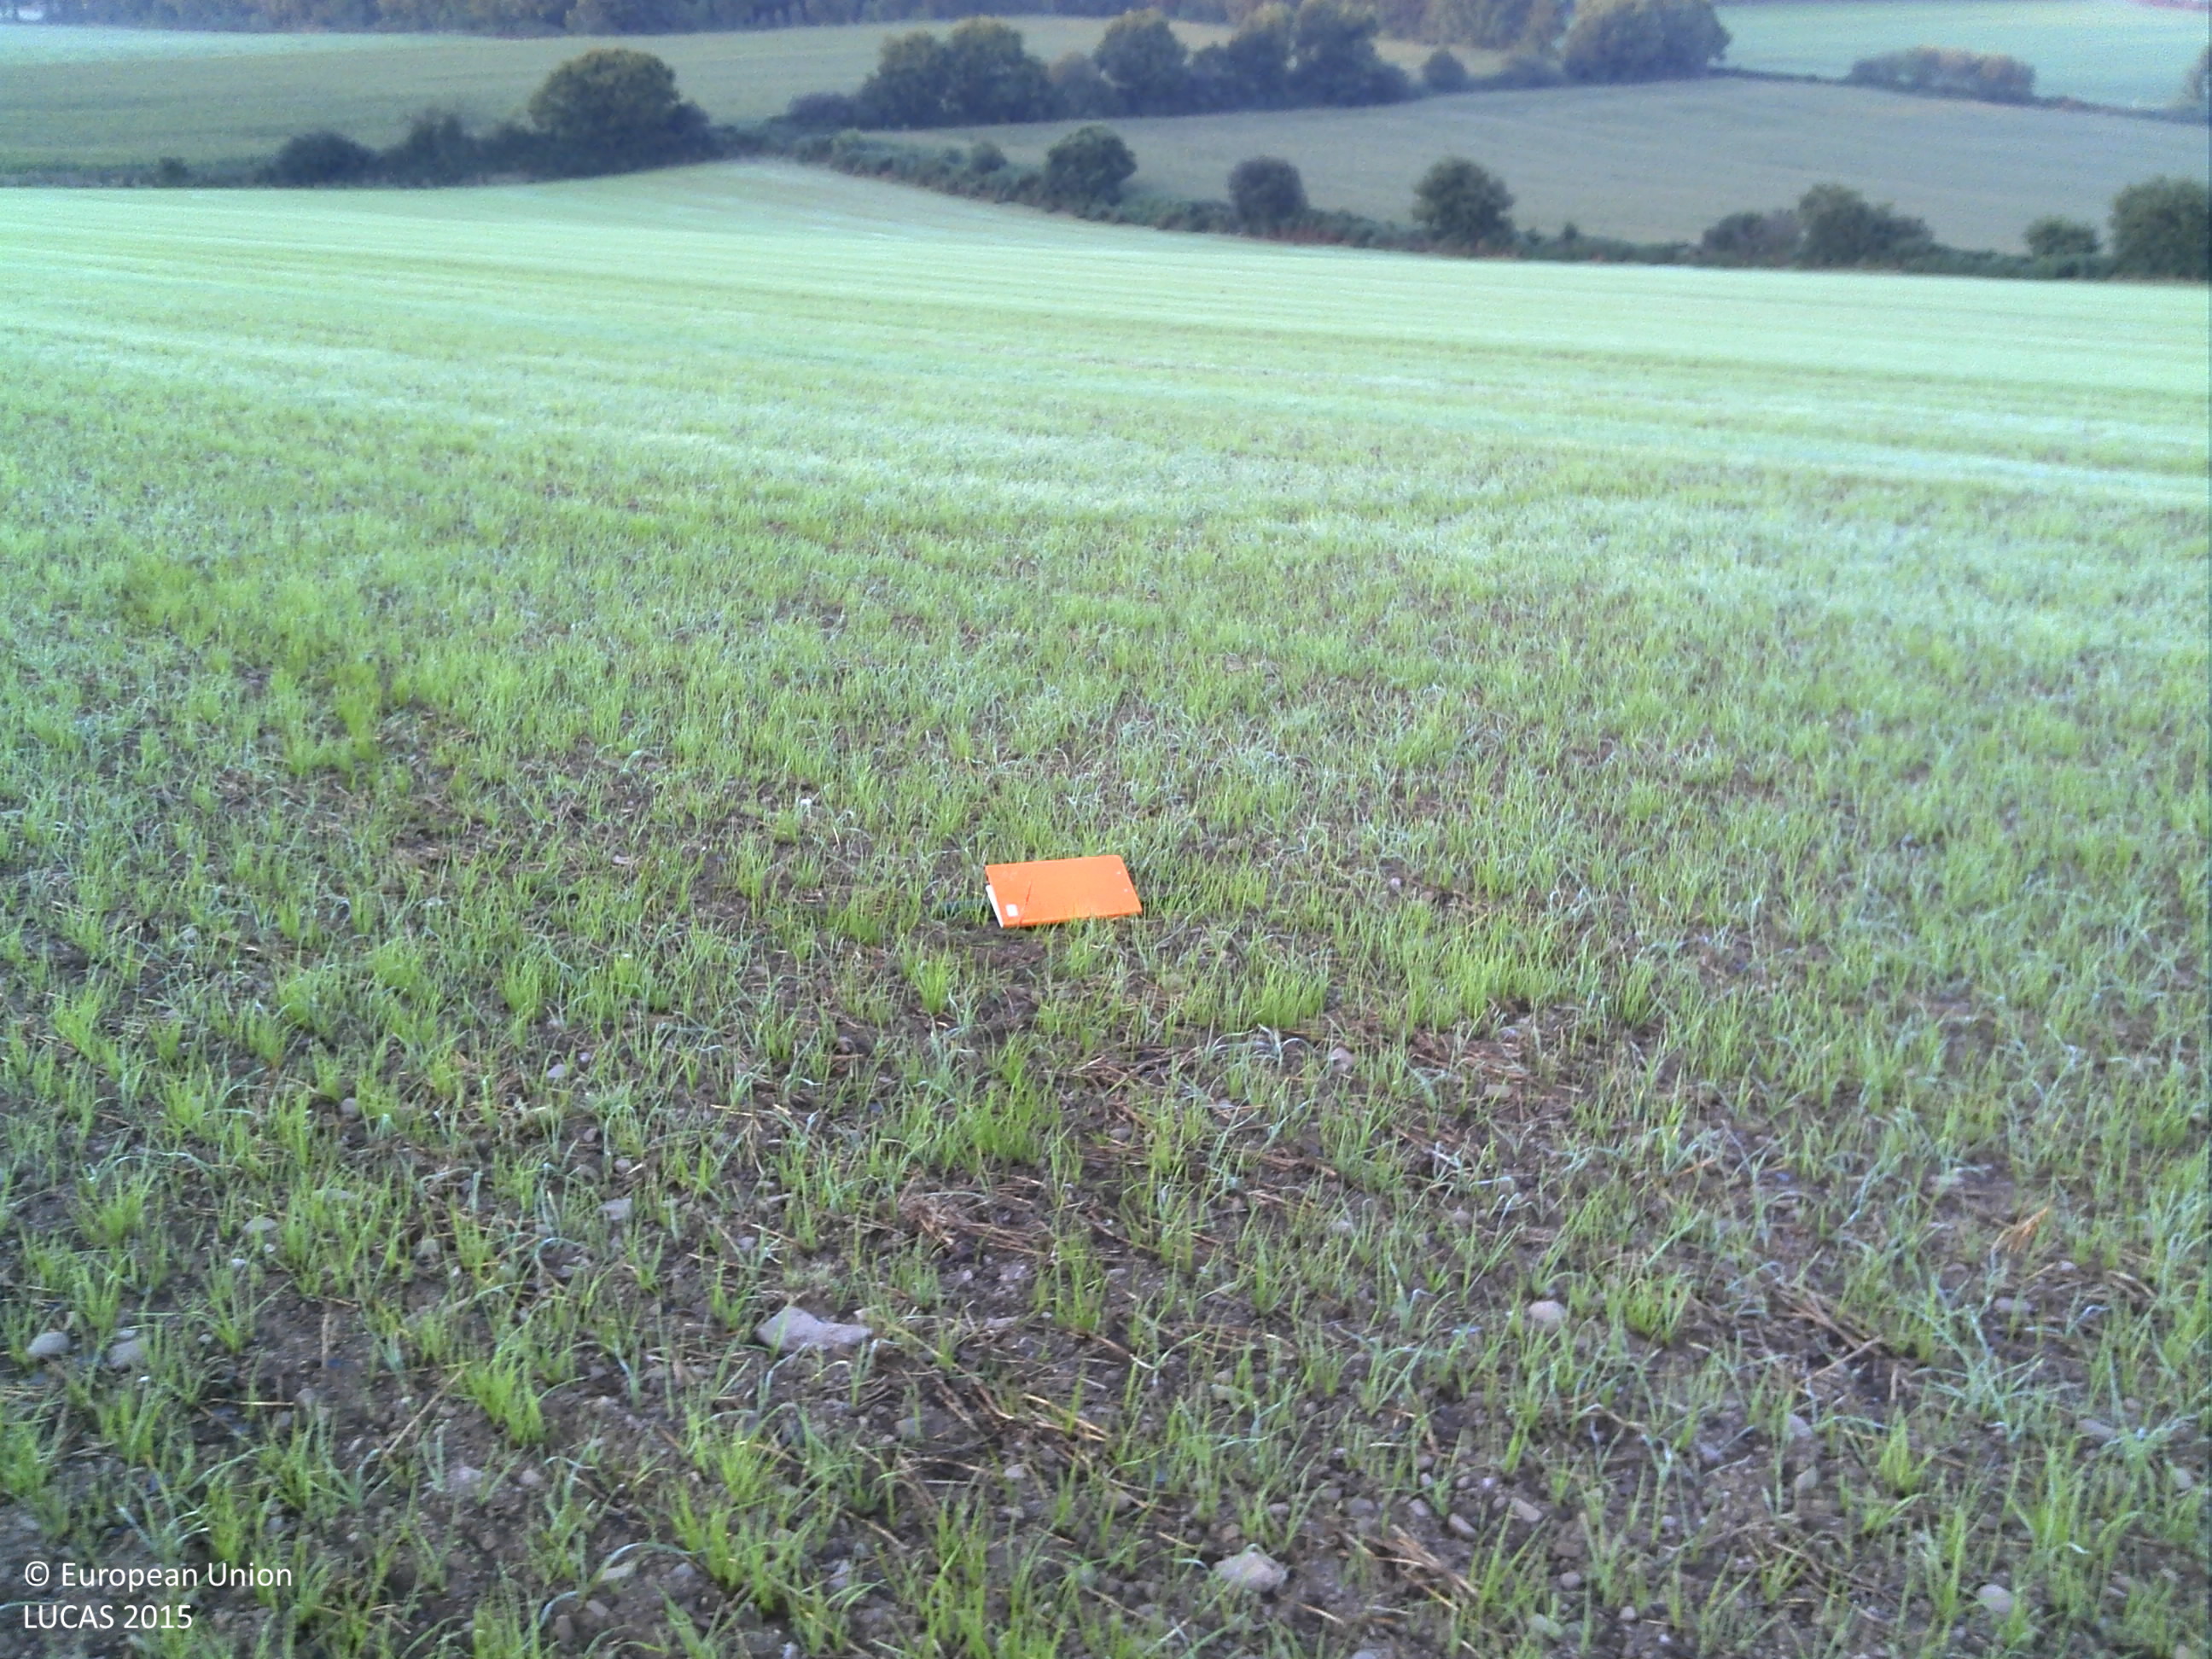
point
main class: Cropland
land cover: Temporary grasslands
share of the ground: 50 - 75 %
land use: Agriculture (excluding fallow land and kitchen gardens)
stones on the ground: 10 - 25 %
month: September
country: FR
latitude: 48.2575
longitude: -3.6994
